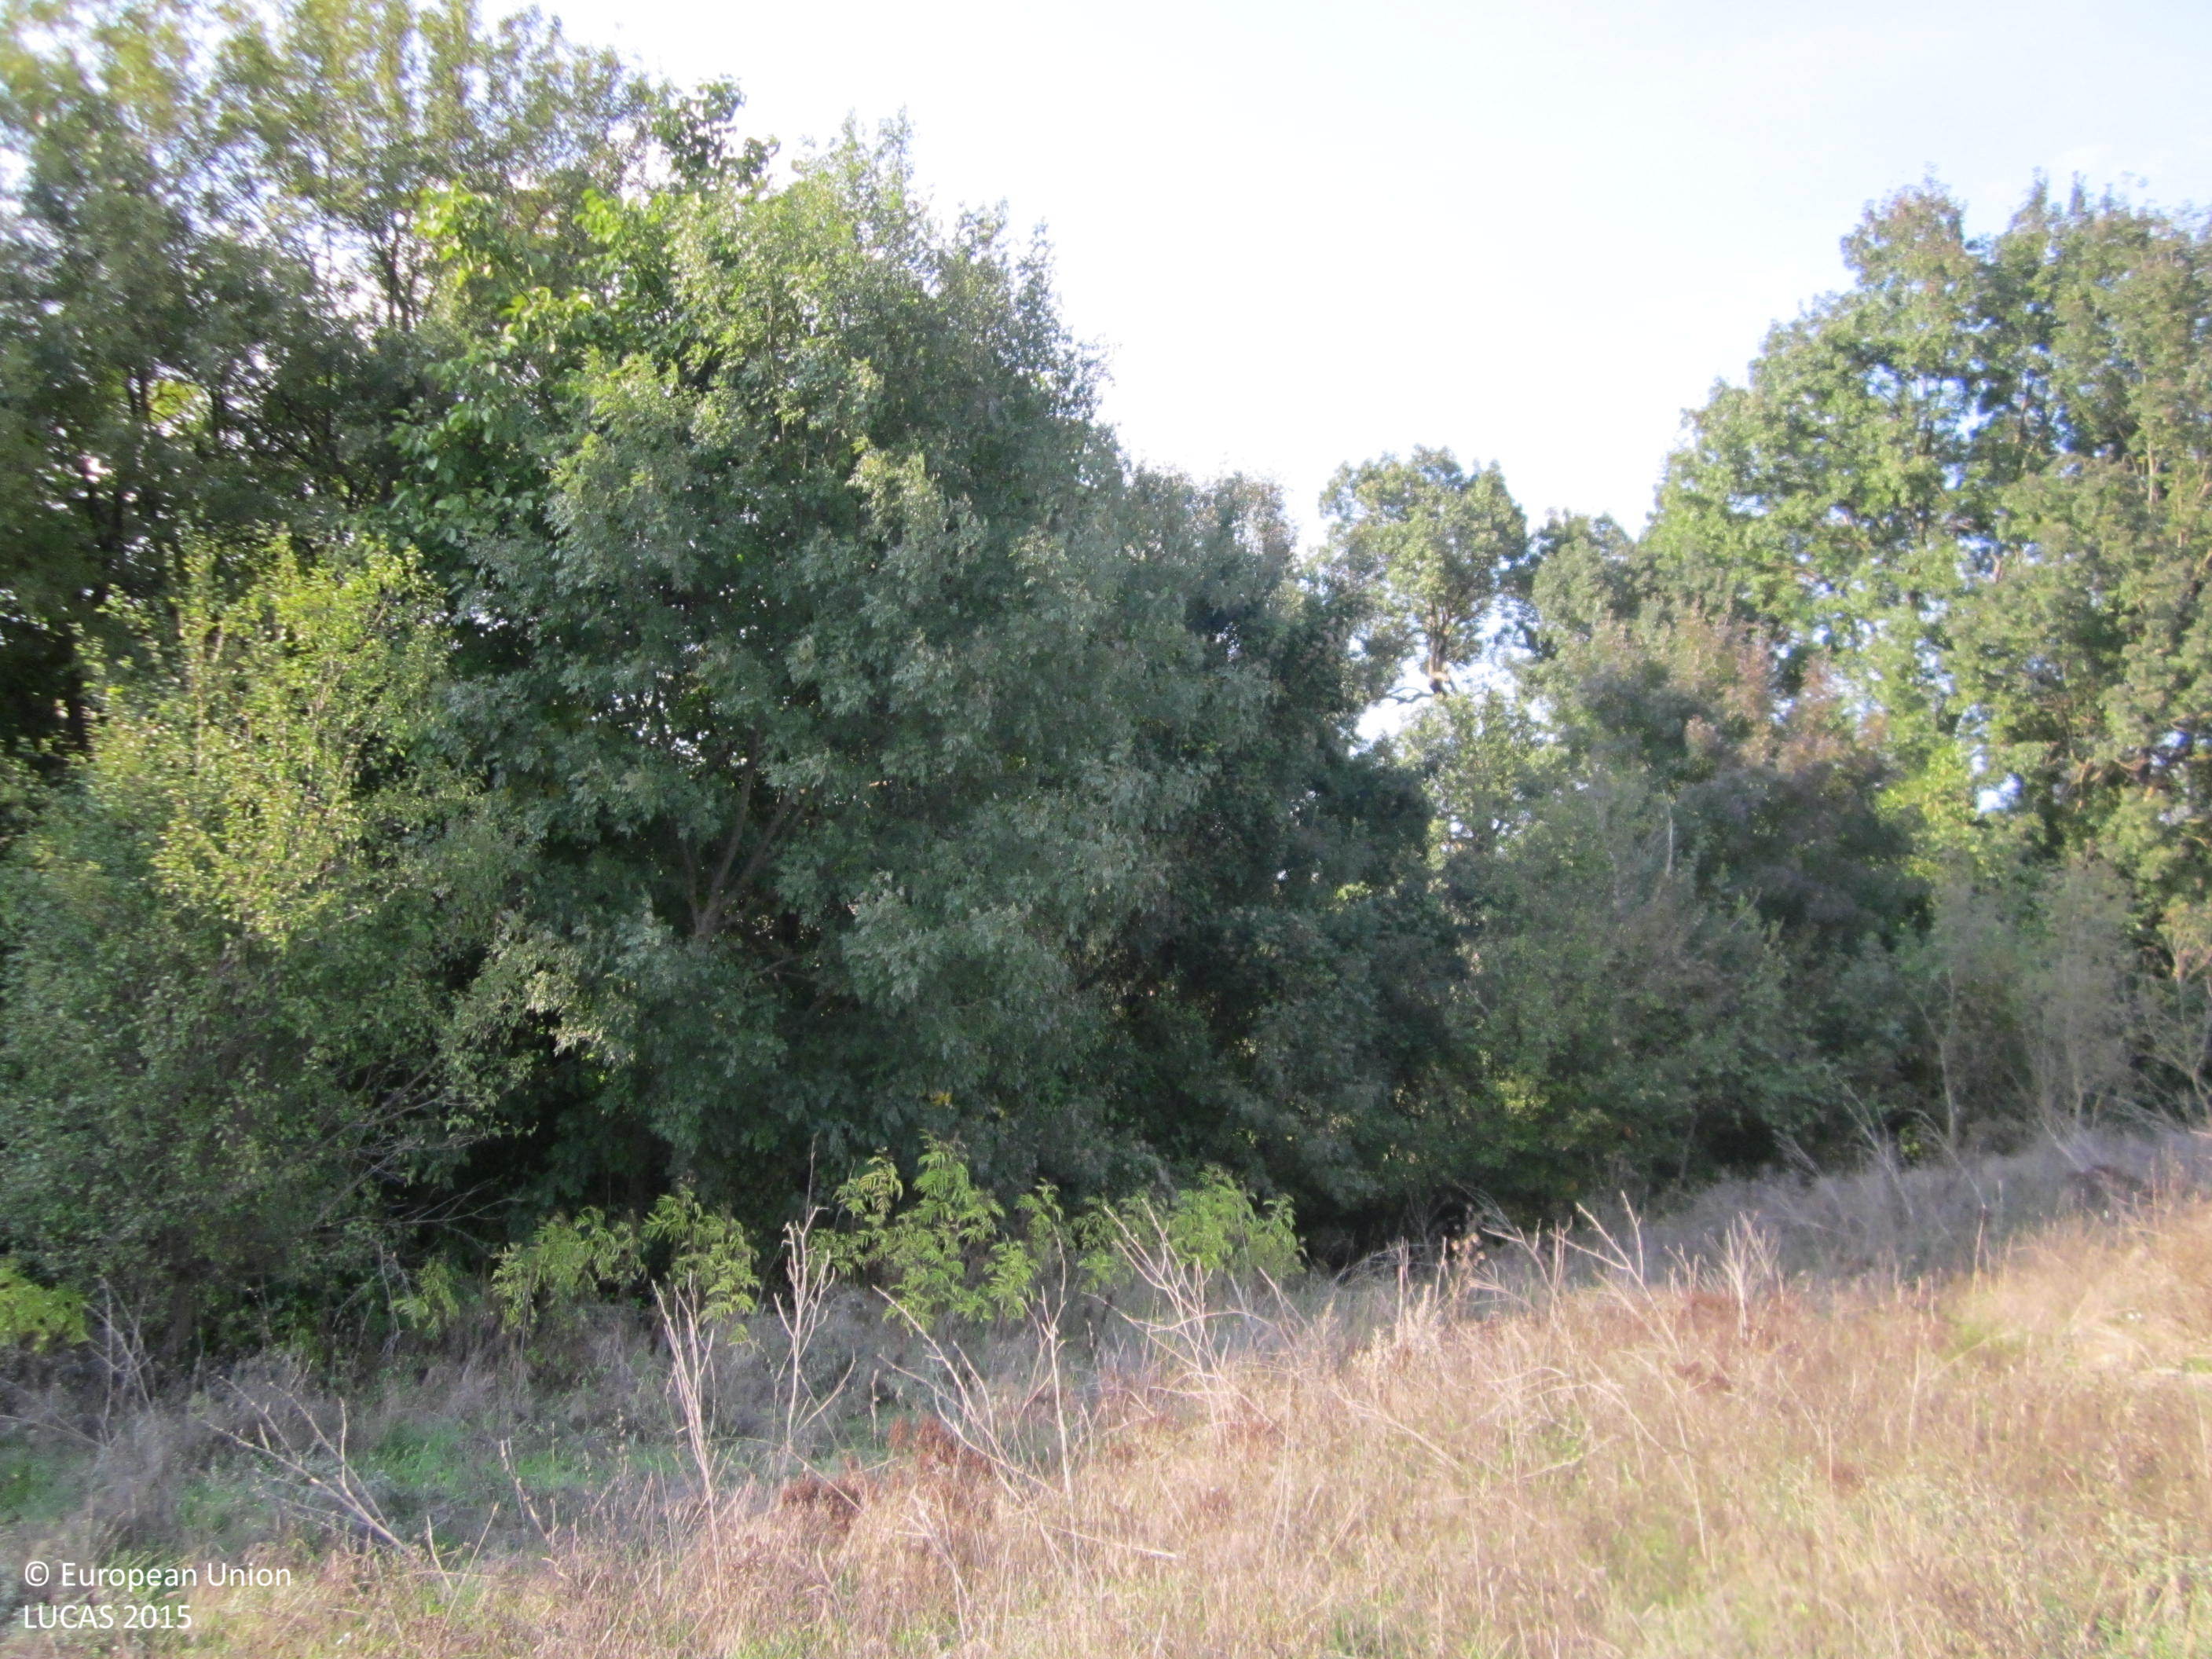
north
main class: Grassland
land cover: Grassland without tree/shrub cover
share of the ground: > 75 %
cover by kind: herbaceous plants 95 %, shrubs 5 %
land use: Agriculture (excluding fallow land and kitchen gardens)
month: October
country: BG
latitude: 42.2996
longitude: 26.9490
